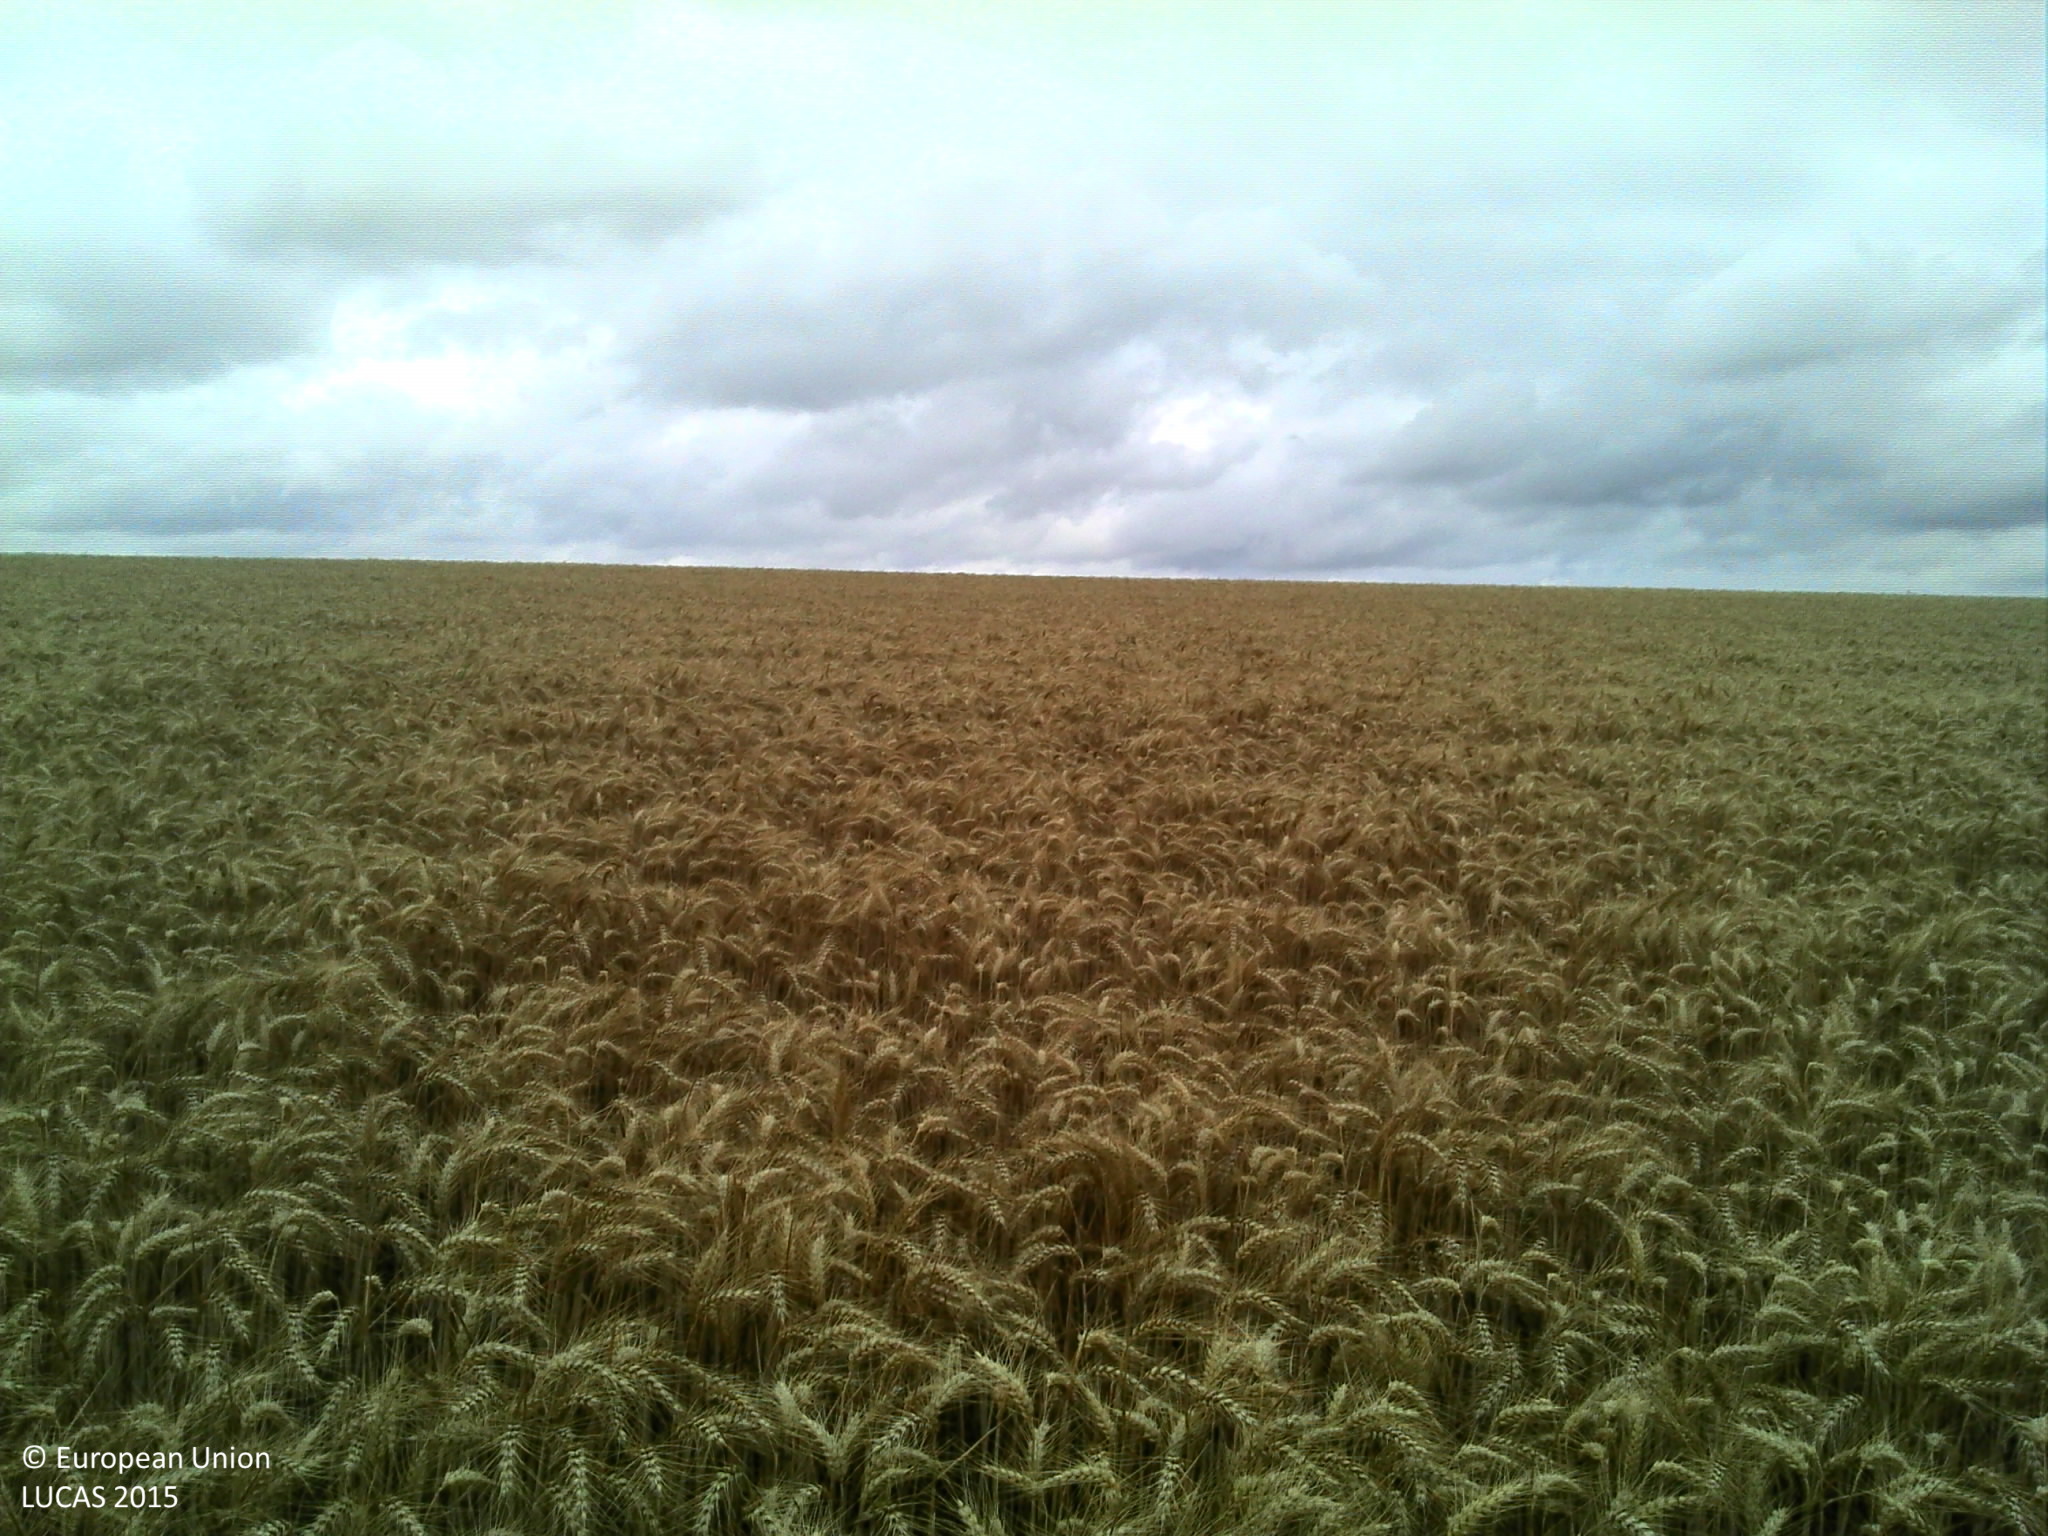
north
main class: Cropland
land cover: Common wheat
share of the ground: > 75 %
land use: Agriculture (excluding fallow land and kitchen gardens)
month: July
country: FR
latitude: 49.8320
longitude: 2.5501
